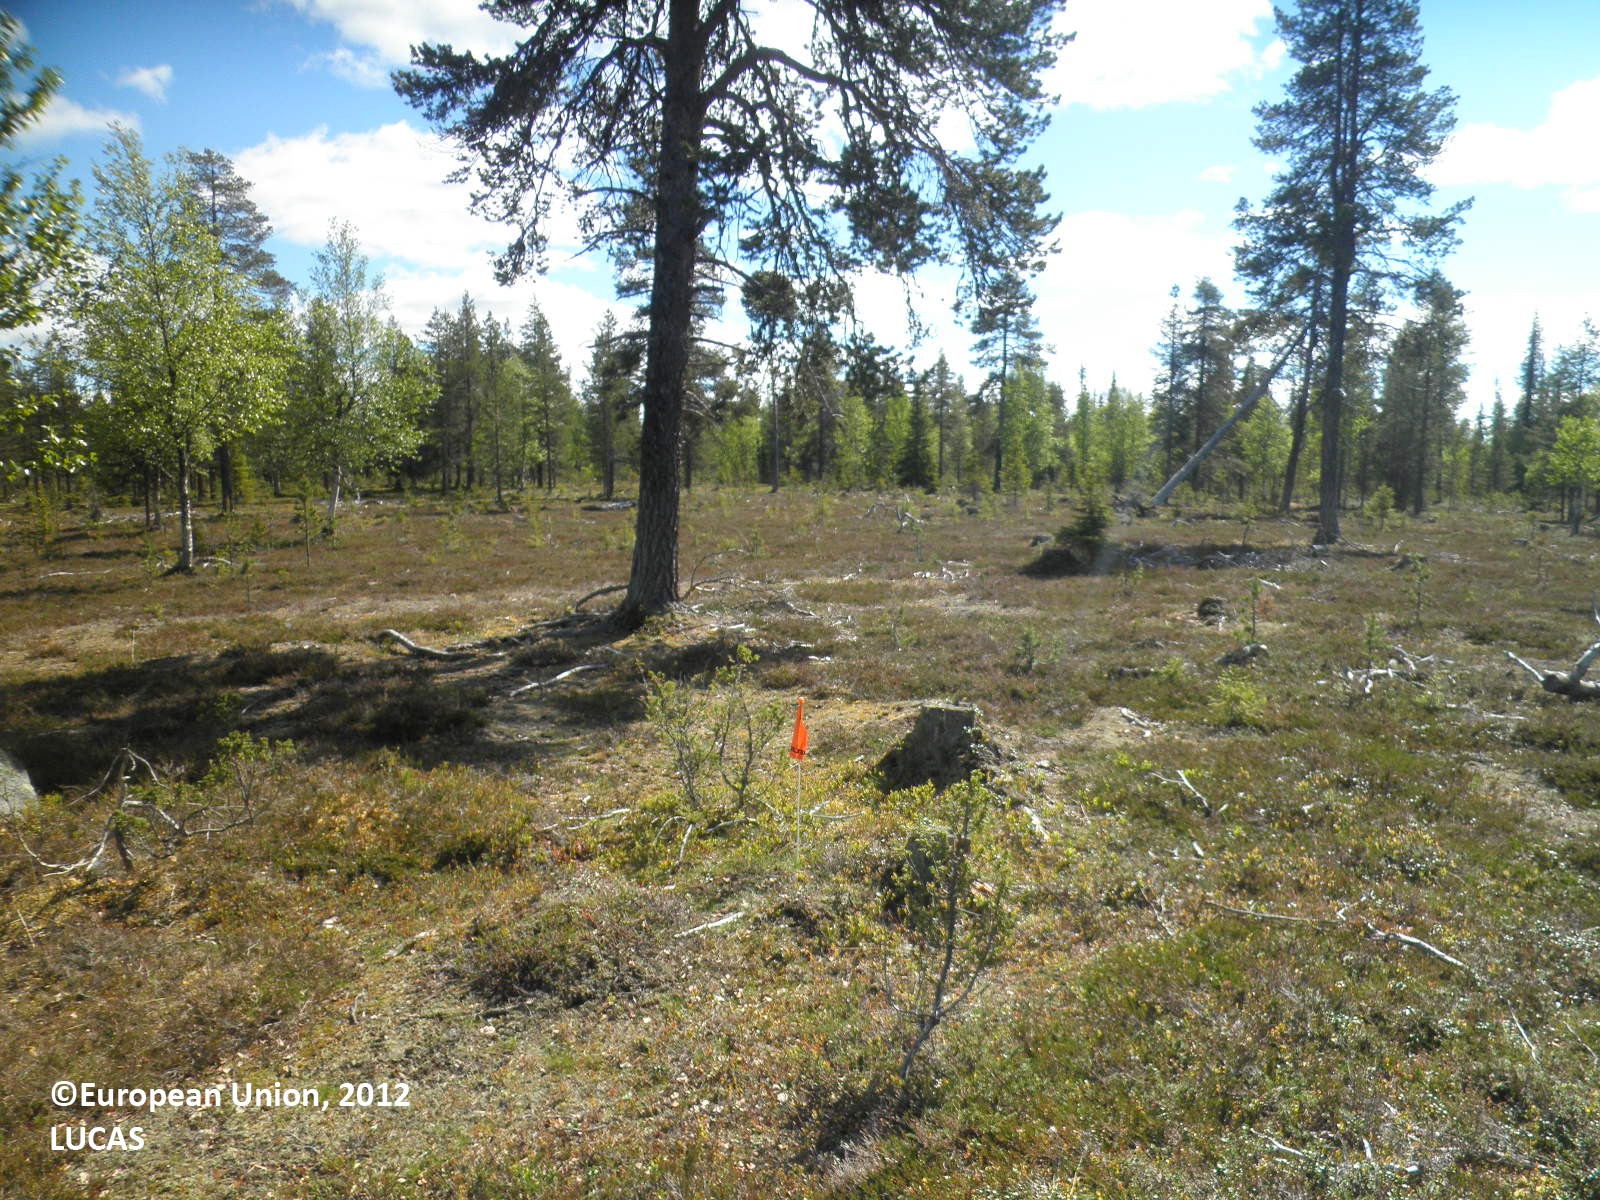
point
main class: Woodland
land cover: Pine dominated mixed woodland
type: boreal forest
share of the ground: 10 - 25 %
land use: Forestry
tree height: > 5 m
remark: Harvested field
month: June
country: FI
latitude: 68.2858
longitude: 26.9007
